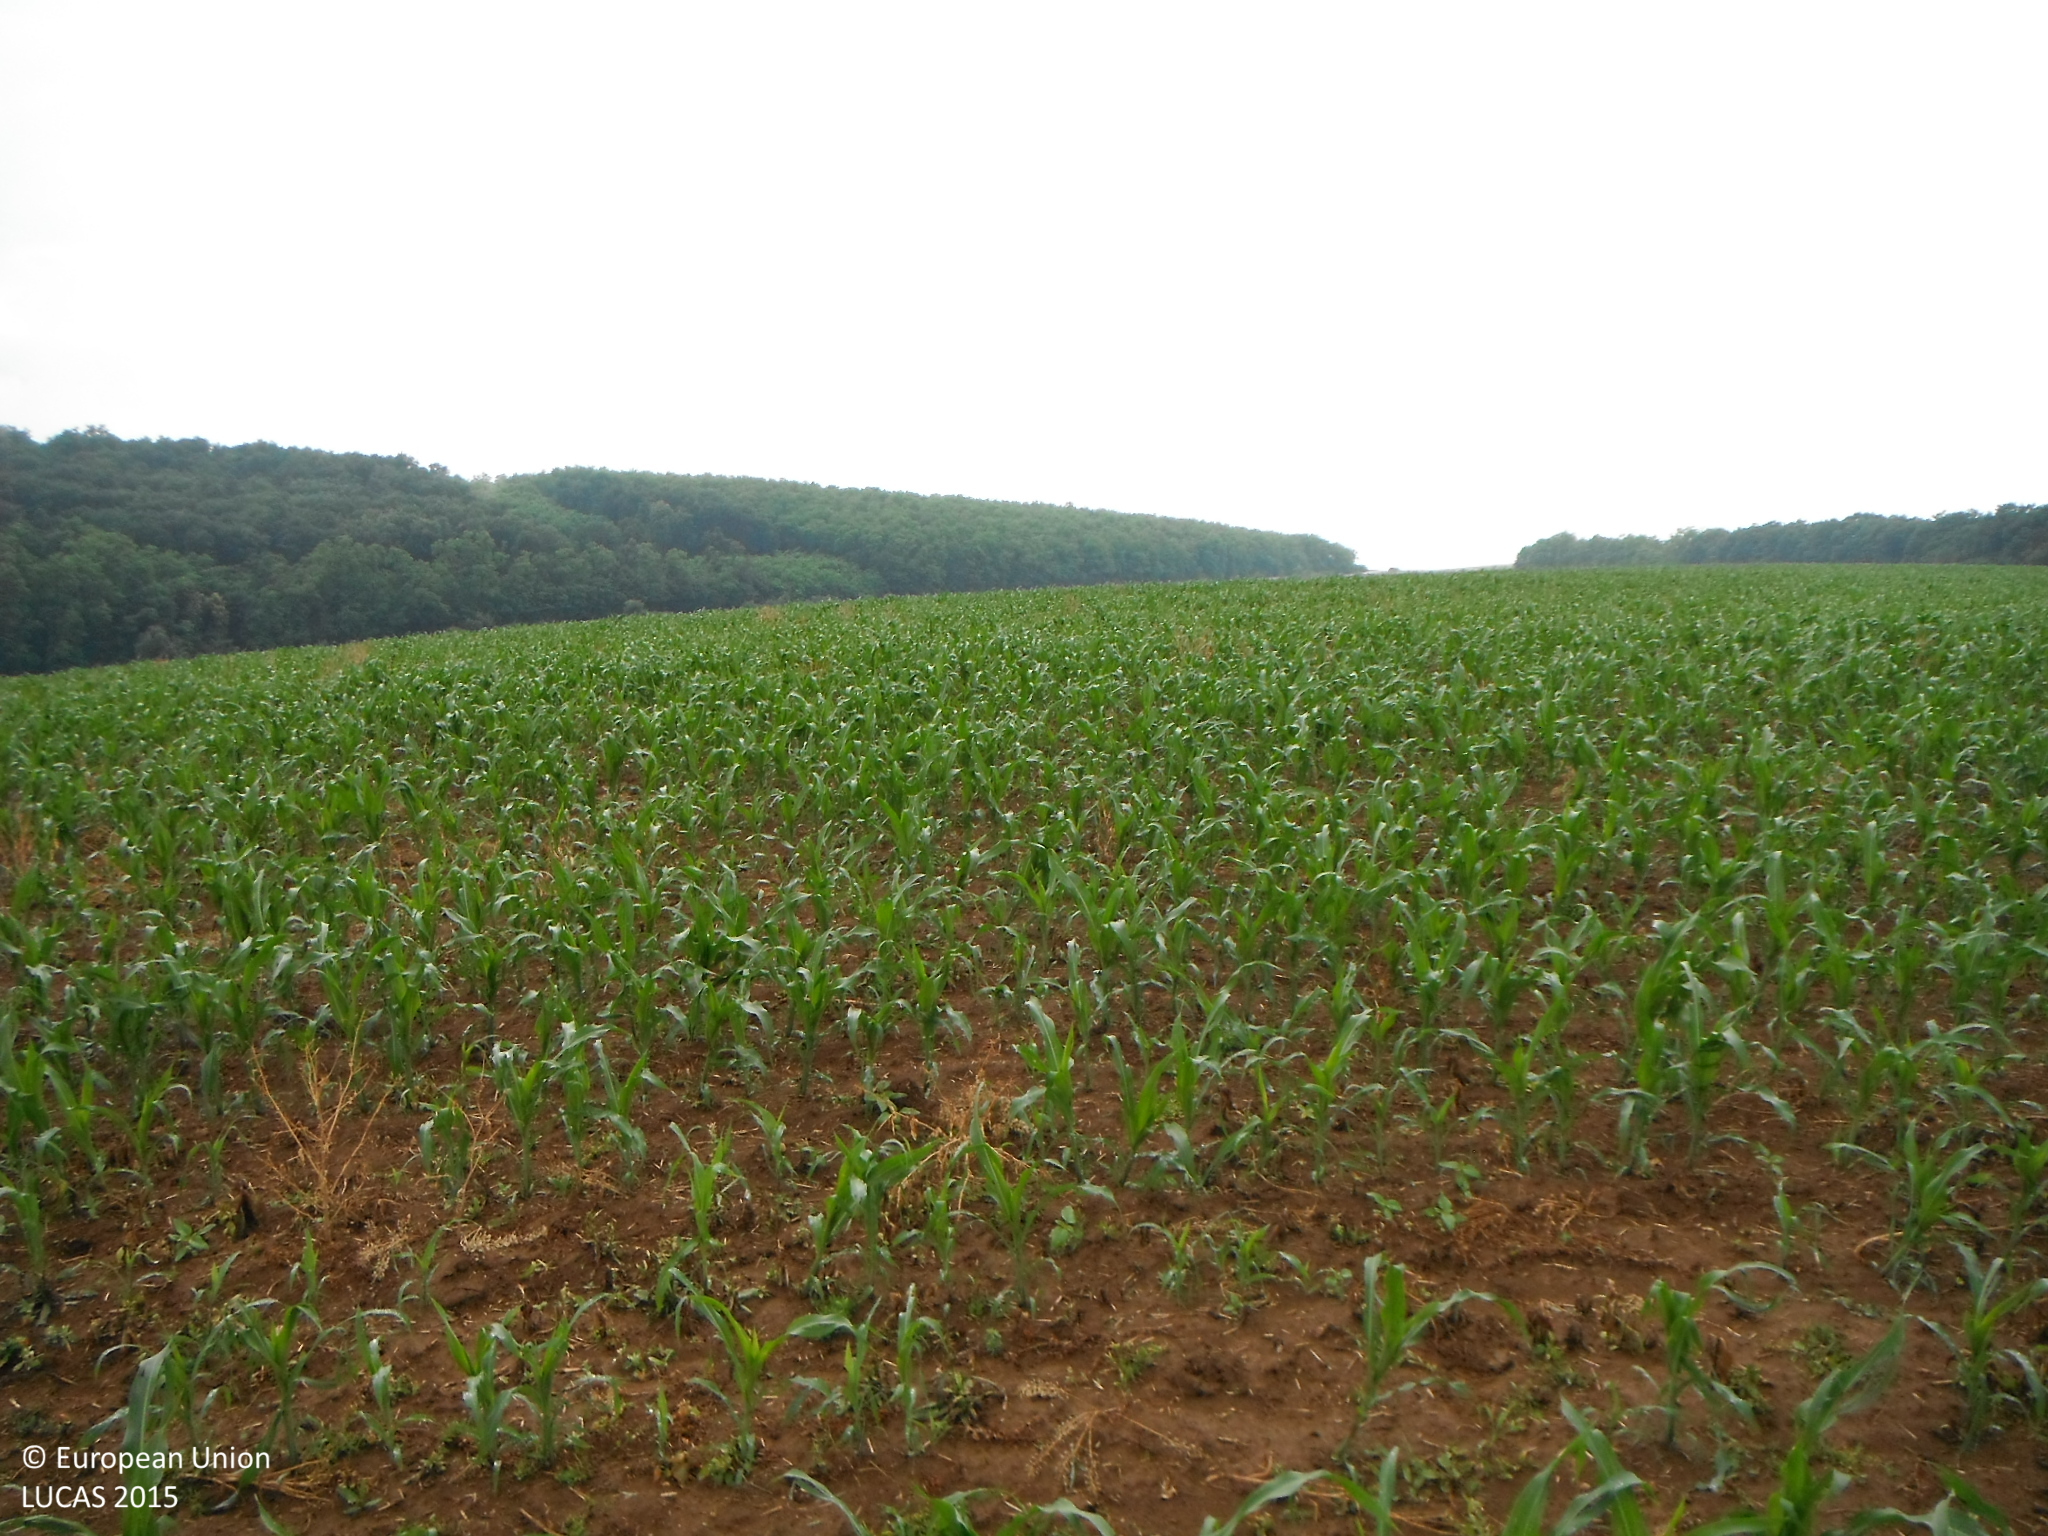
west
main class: Cropland
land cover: Maize
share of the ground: 50 - 75 %
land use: Agriculture (excluding fallow land and kitchen gardens)
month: June
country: SK
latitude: 48.1188
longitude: 18.8711
